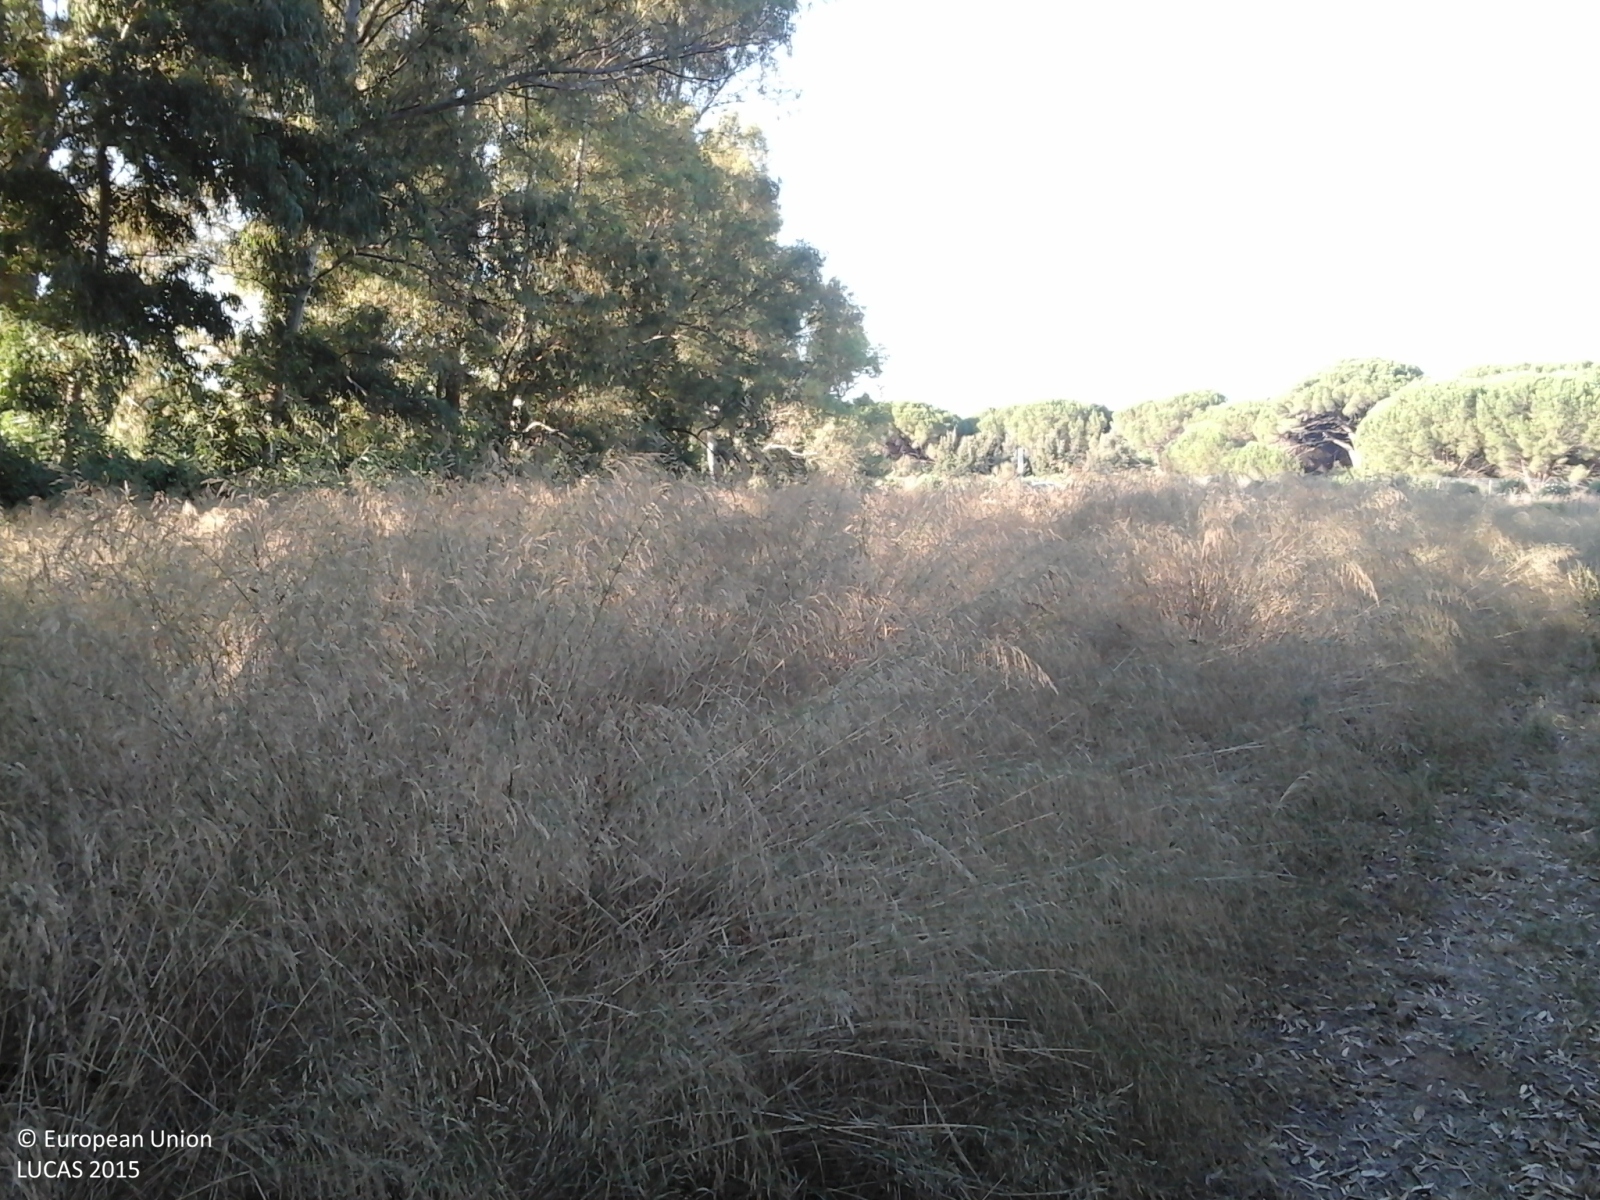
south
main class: Woodland
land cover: Pine dominated mixed woodland
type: broadleaved evergreen forest
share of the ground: > 75 %
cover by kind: coniferous forest trees 75 %, broadleaved forest trees 25 %
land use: Forestry
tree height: > 5 m
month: August
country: IT
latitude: 42.7770
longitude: 10.8406
